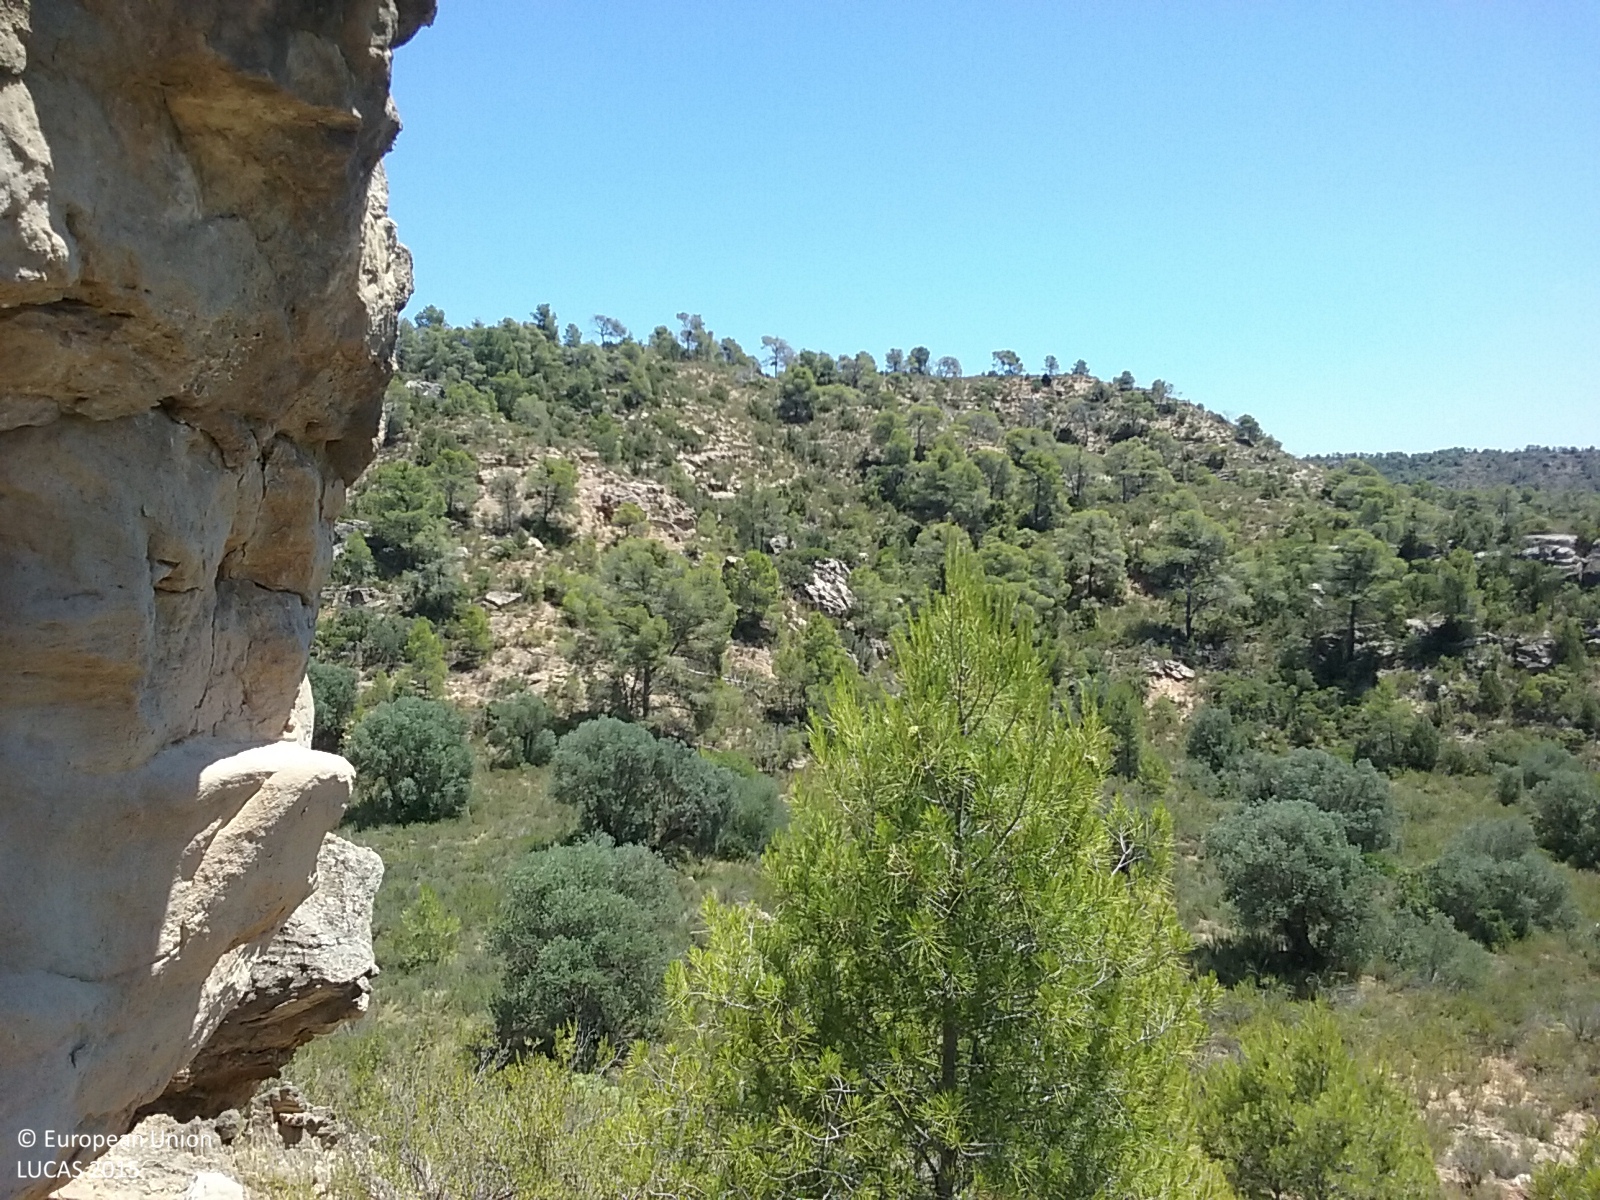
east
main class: Woodland
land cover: Pine dominated coniferous woodland
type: coniferous forest of the mediterranean region
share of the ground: 25 - 50 %
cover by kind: coniferous forest trees 40 %, shrubs 40 %, herbaceous plants 20 %
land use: Semi-natural and natural areas not in use
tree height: > 5 m
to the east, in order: Pine dominated coniferous woodland; Olive groves; Dry stone walls; Olive groves; Dry stone walls; Tracks; Olive groves; Dry stone walls; Olive groves; Dry stone walls; Olive groves; Pine dominated coniferous woodland
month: June
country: ES
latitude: 41.2770
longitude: 0.4747
